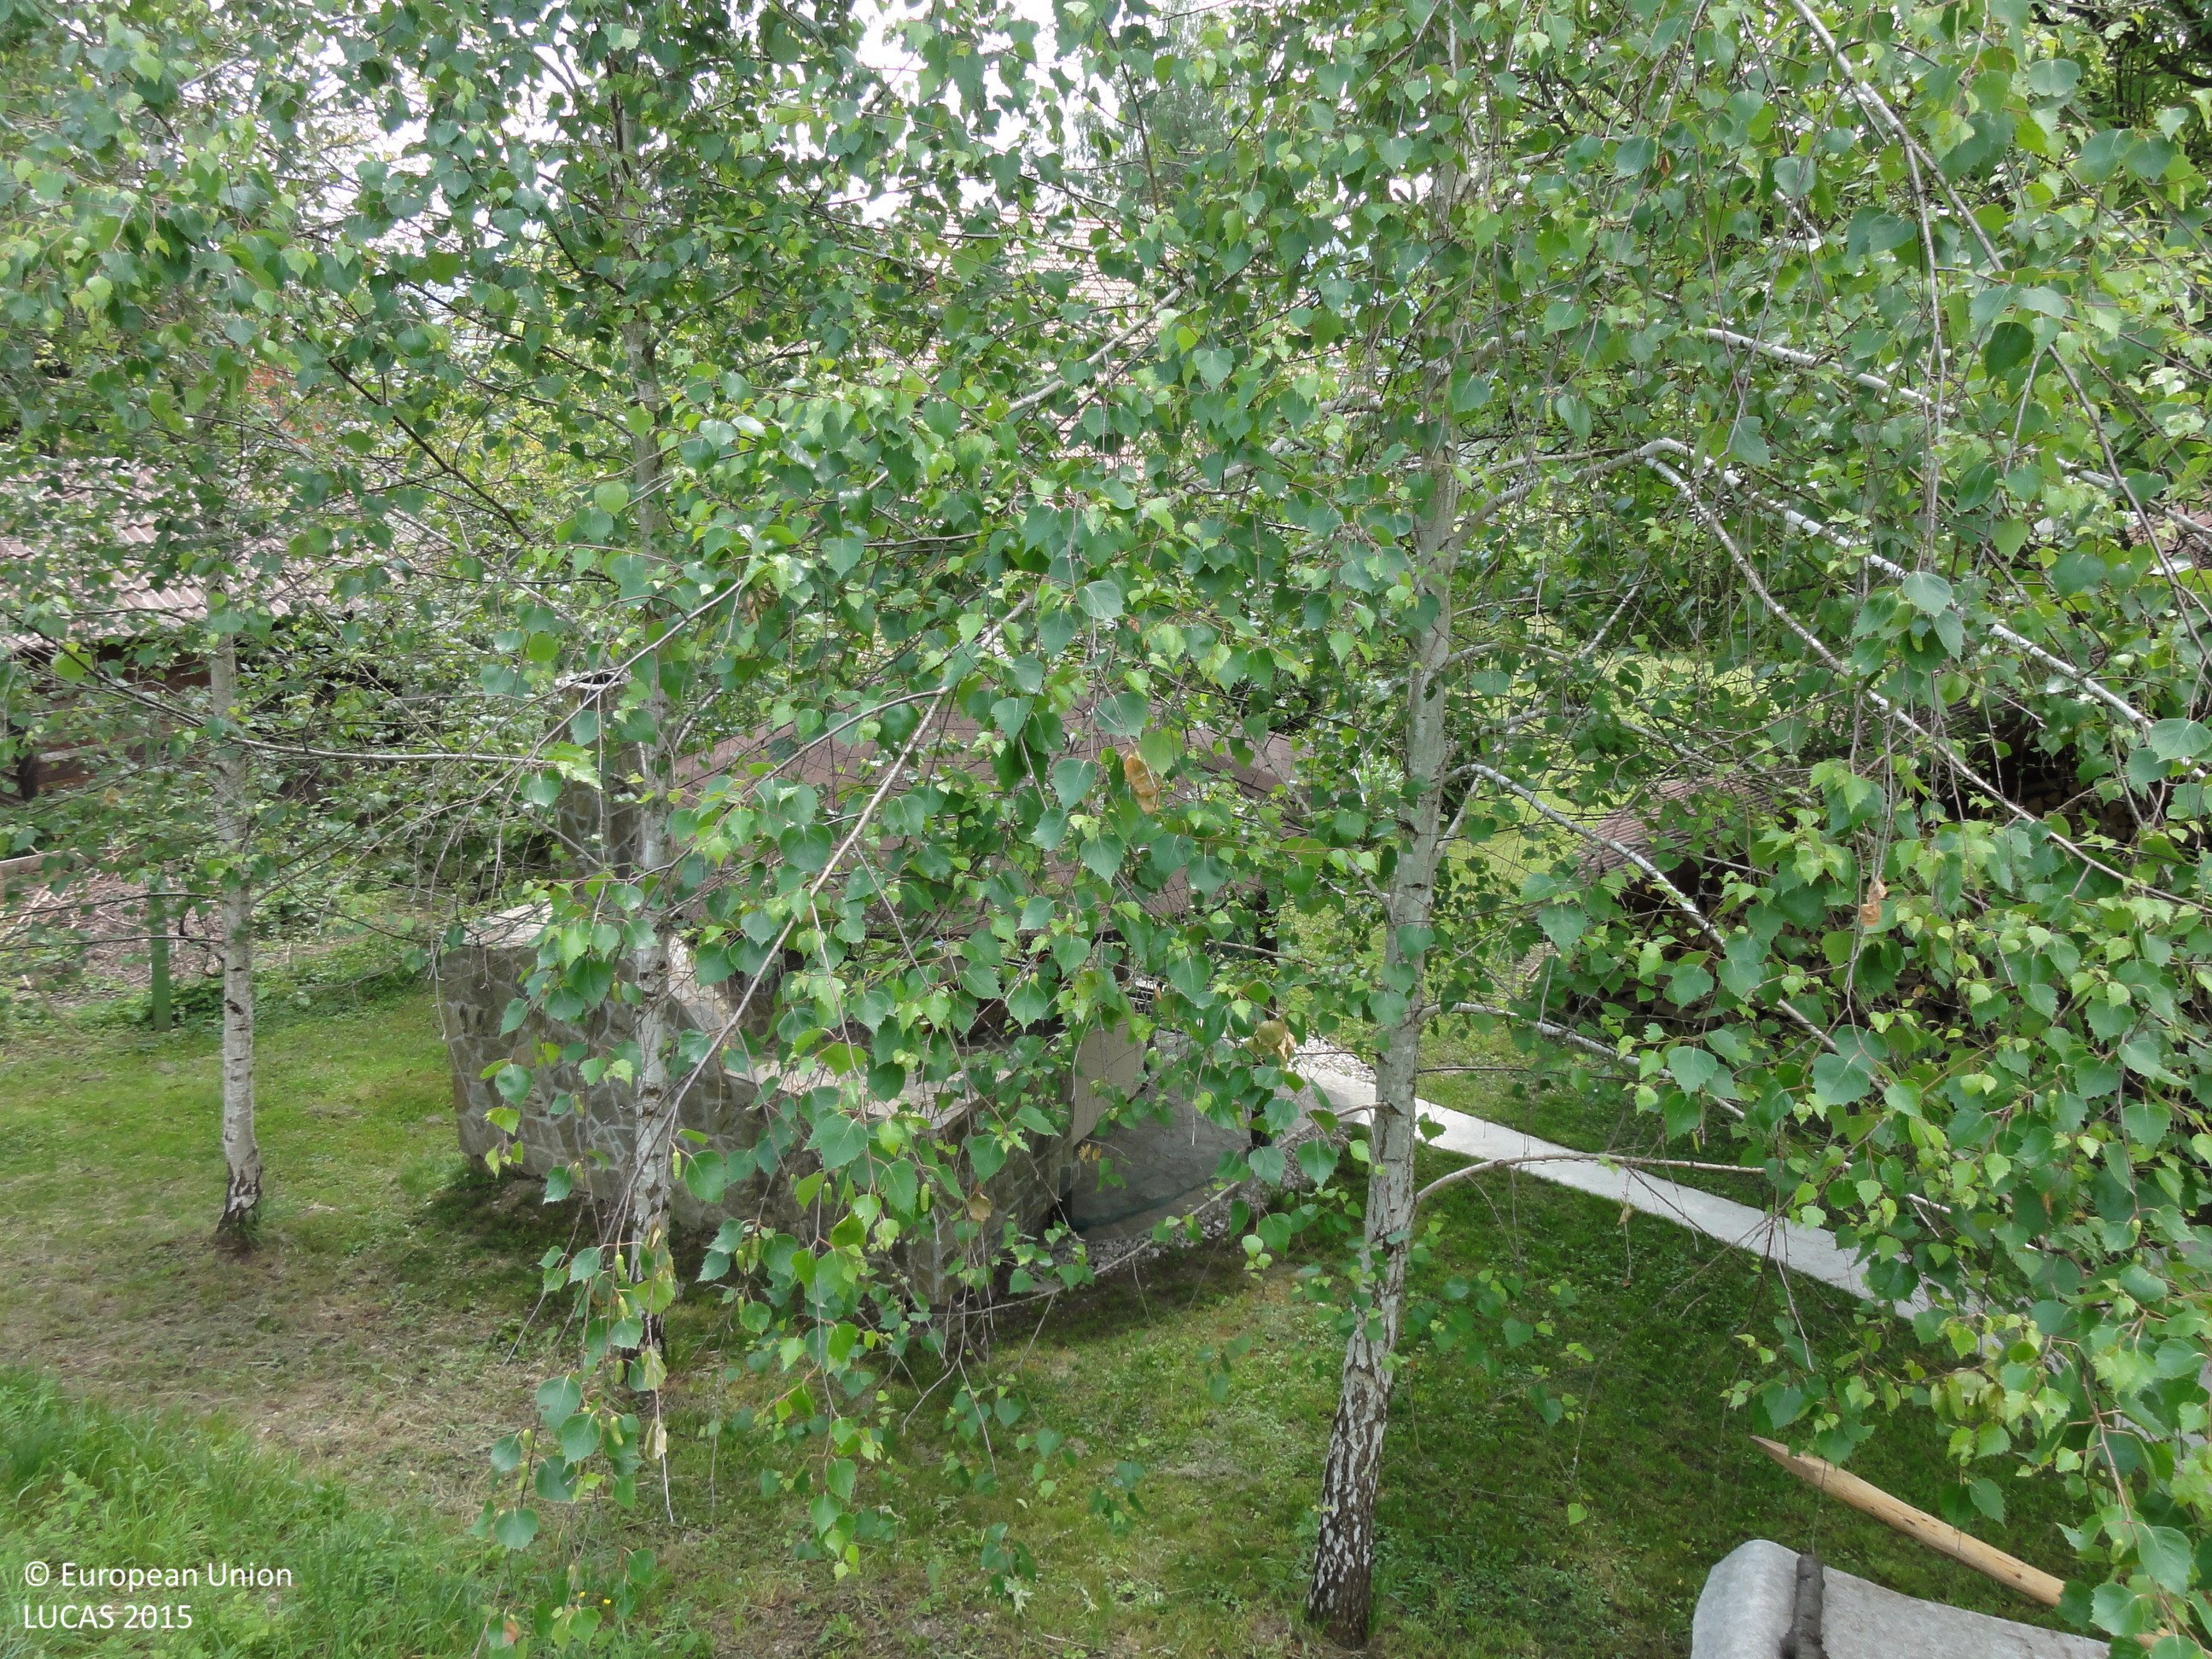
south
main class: Grassland
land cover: Grassland with sparse tree/shrub cover
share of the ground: > 75 %
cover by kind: herbaceous plants 90 %, broadleaved forest trees 5 %, shrubs 5 %
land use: Residential
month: May
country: SI
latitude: 46.2658
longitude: 15.0966
